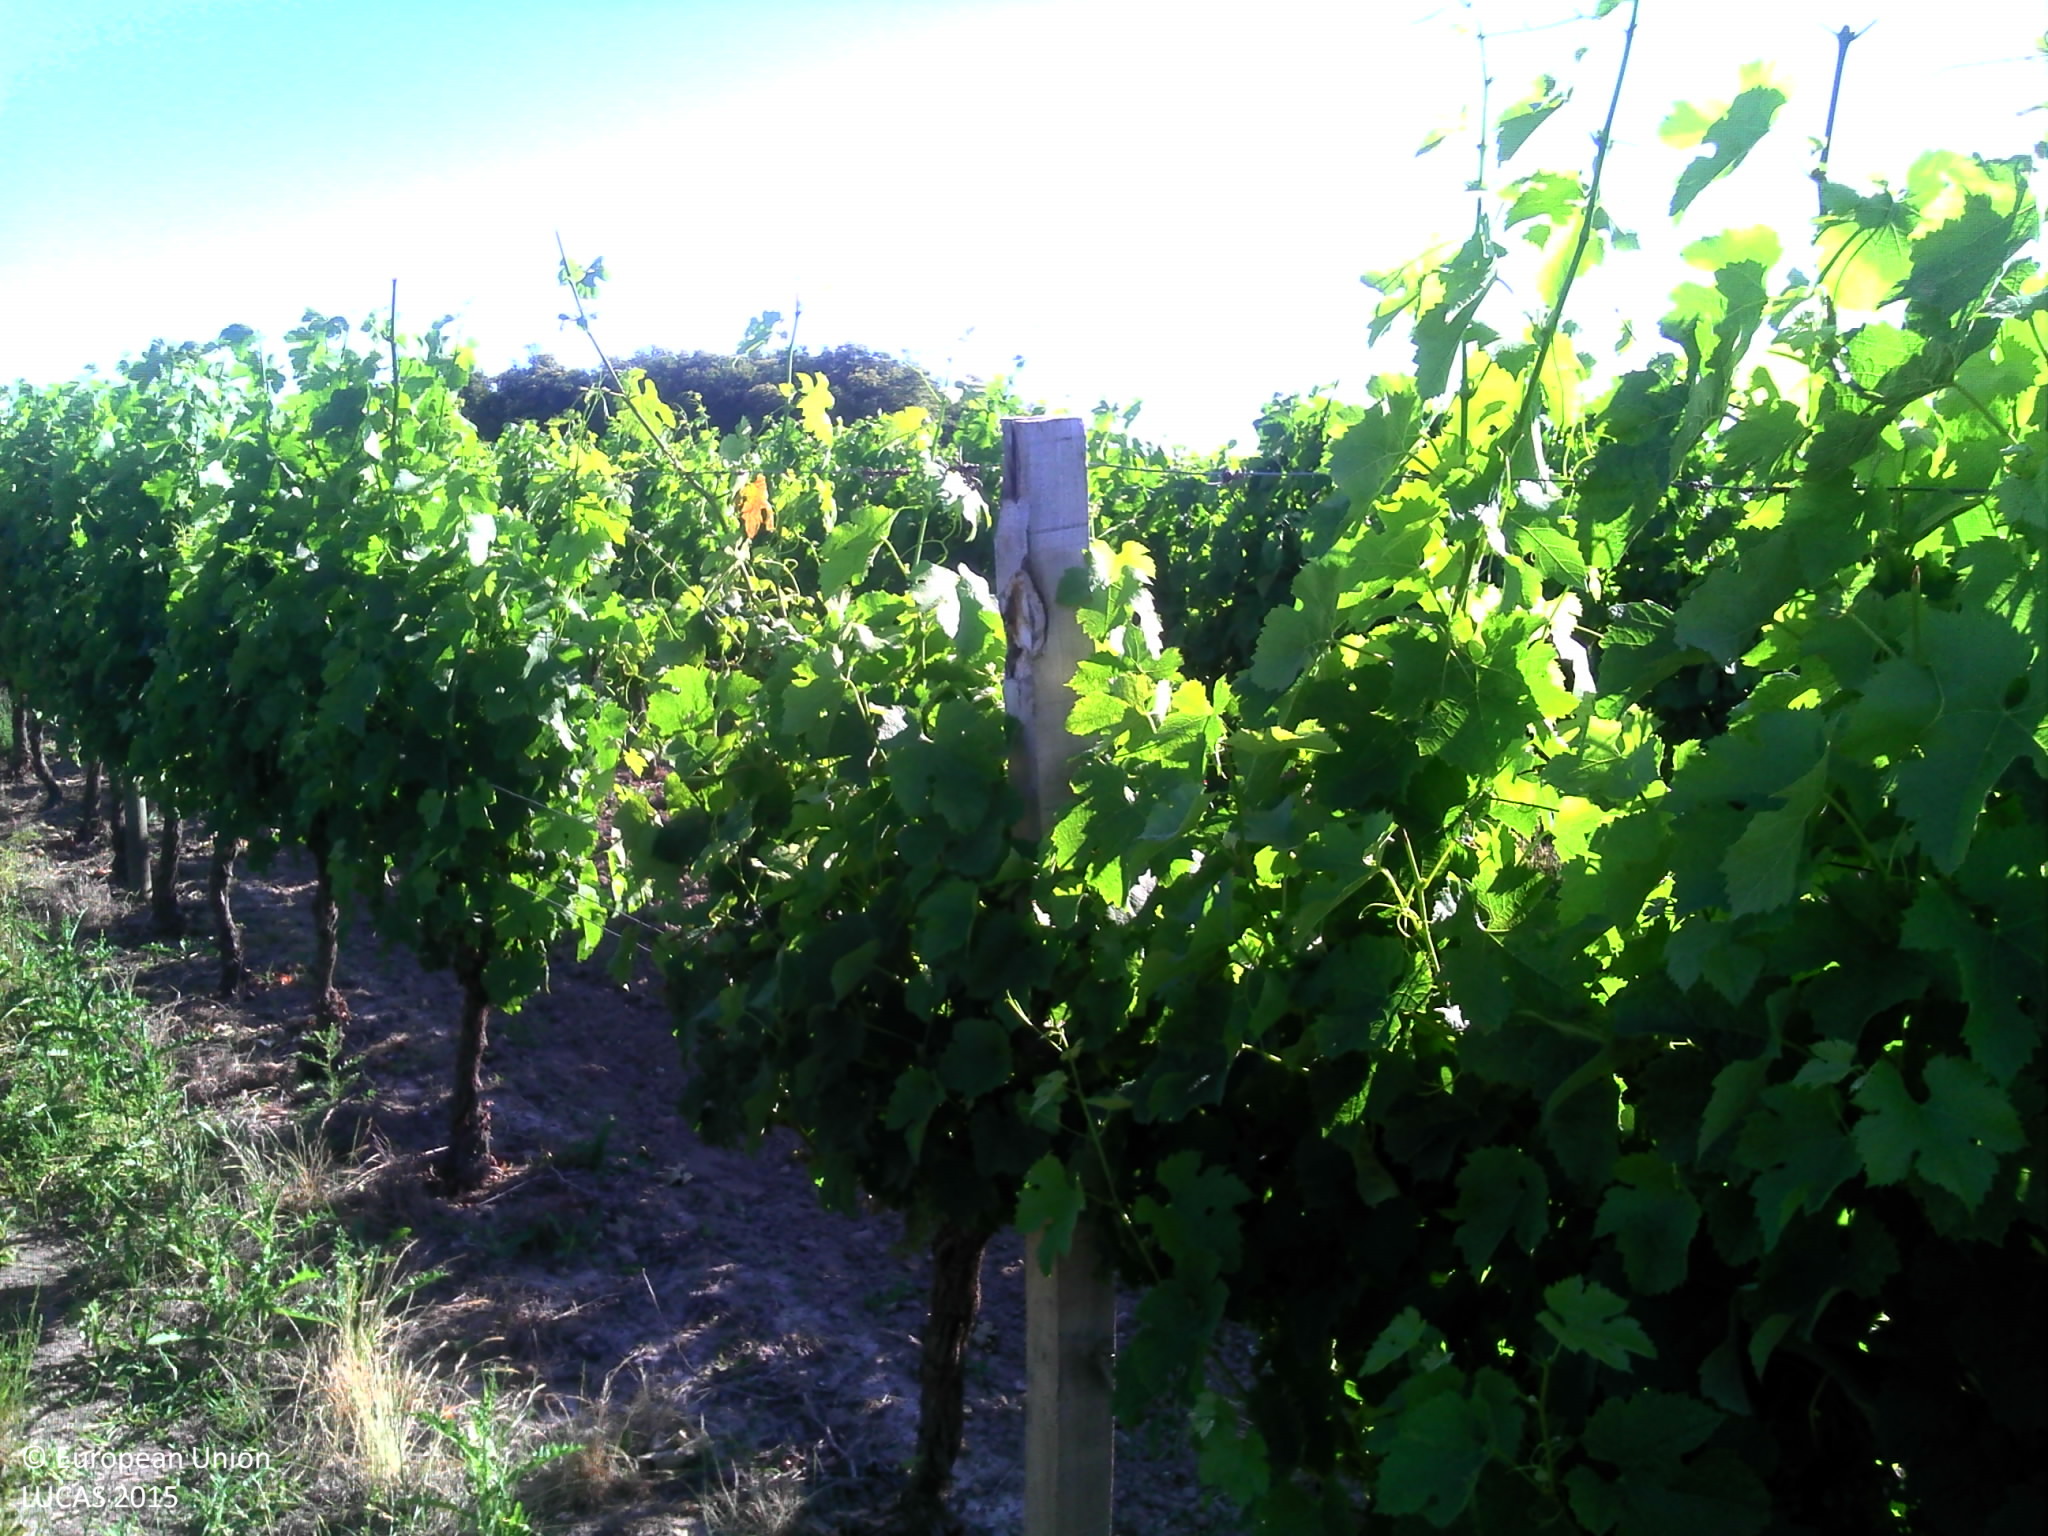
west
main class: Cropland
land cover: Vineyards
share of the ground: 25 - 50 %
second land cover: Grassland without tree/shrub cover
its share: 50 - 75 %
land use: Agriculture (excluding fallow land and kitchen gardens)
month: June
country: FR
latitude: 45.5843
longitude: -0.8039
